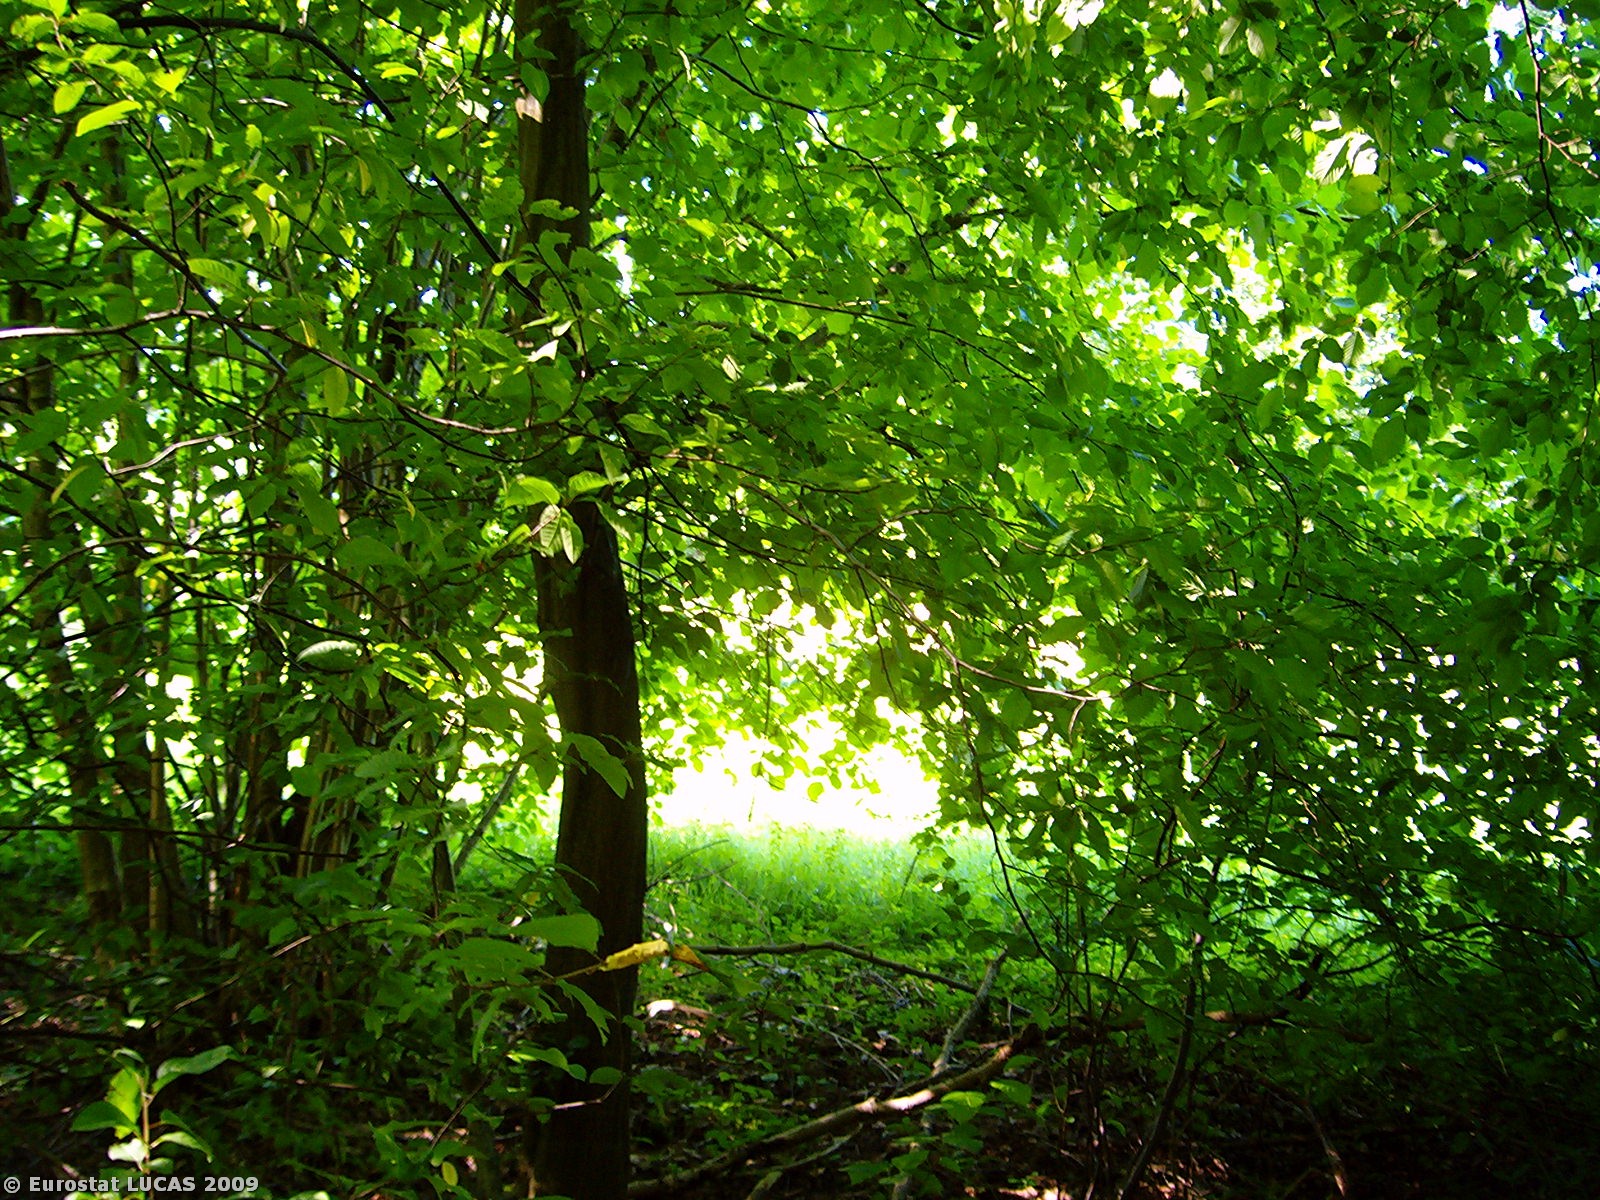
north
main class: Woodland
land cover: Mixed woodland
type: hemiboreal forest and nemoral coniferous forest and mixed broadleaved-coniferous forest
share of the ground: > 75 %
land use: Forestry
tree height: > 5 m
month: June
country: PL
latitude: 53.8056
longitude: 15.3630
